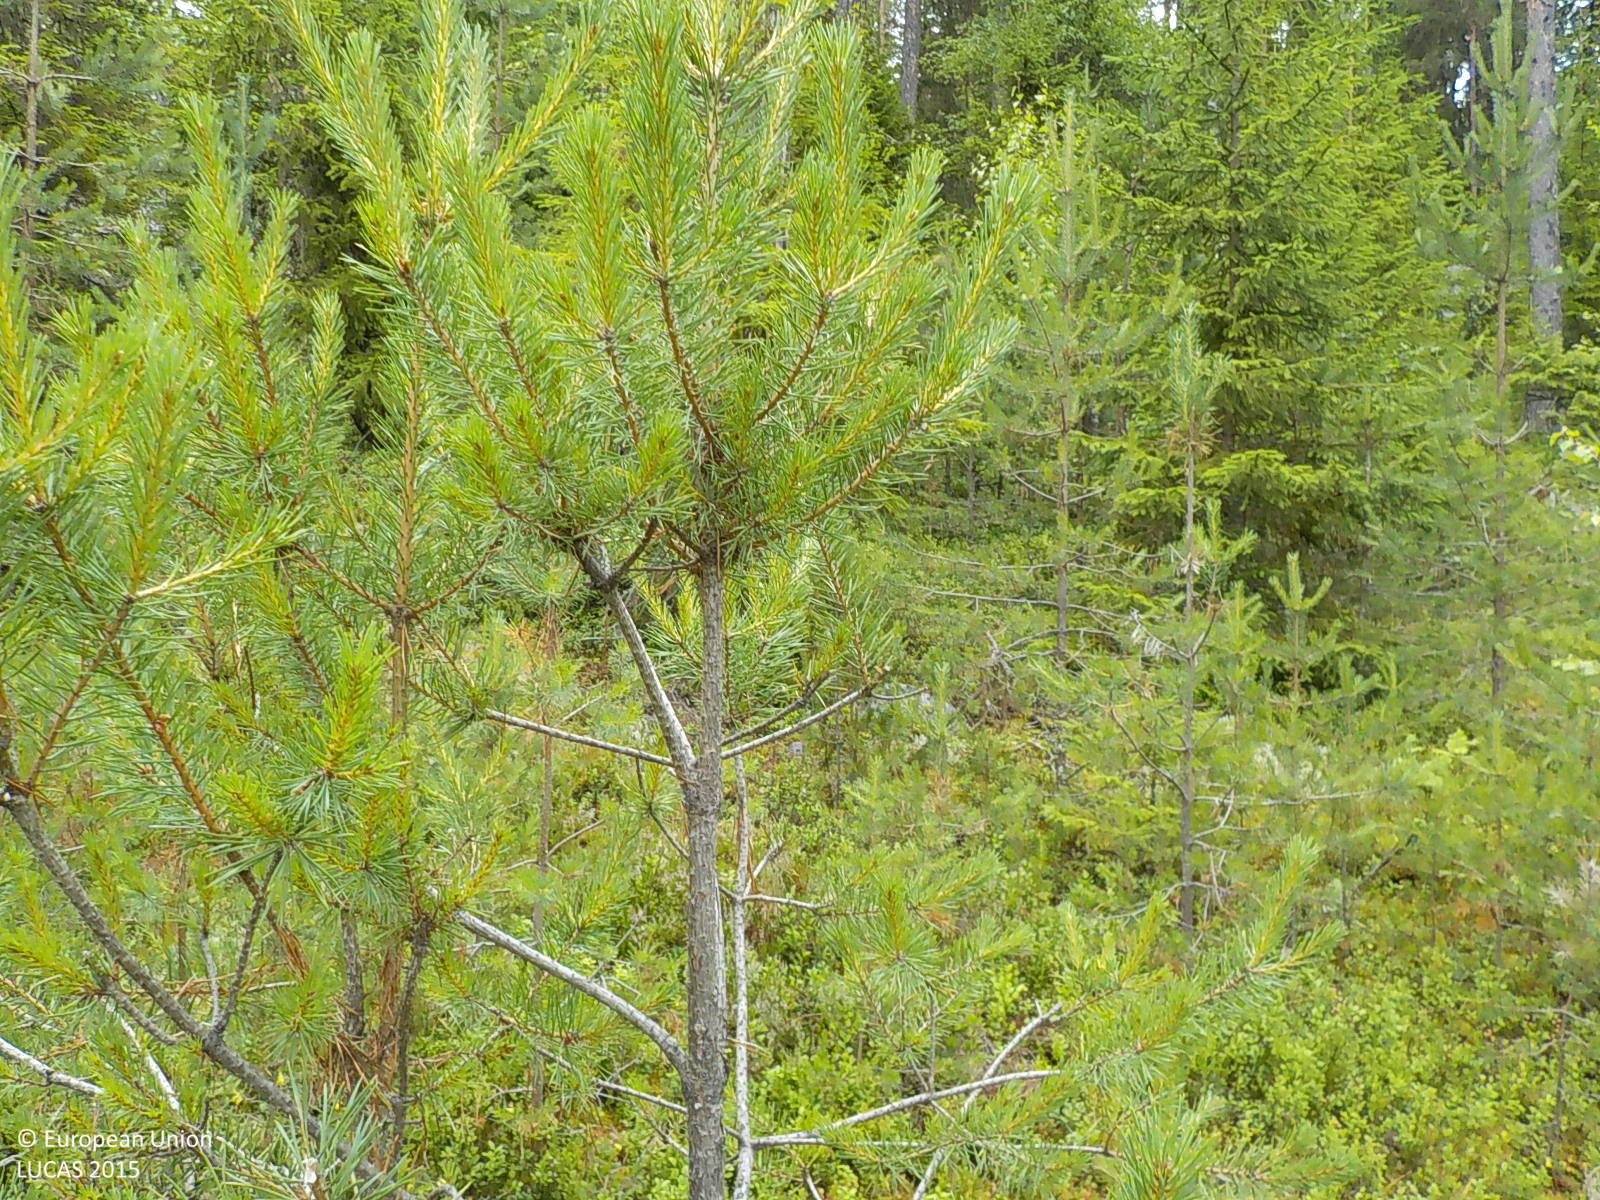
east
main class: Woodland
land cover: Pine dominated coniferous woodland
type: boreal forest
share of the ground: > 75 %
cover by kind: coniferous forest trees 80 %, lichens and mosses 10 %, consolidated bare surface 10 %
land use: Forestry
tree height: > 5 m
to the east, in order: Pine dominated coniferous woodland; Pine dominated mixed woodland; Pine dominated coniferous woodland
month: July
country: SE
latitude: 63.2534
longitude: 17.2448
